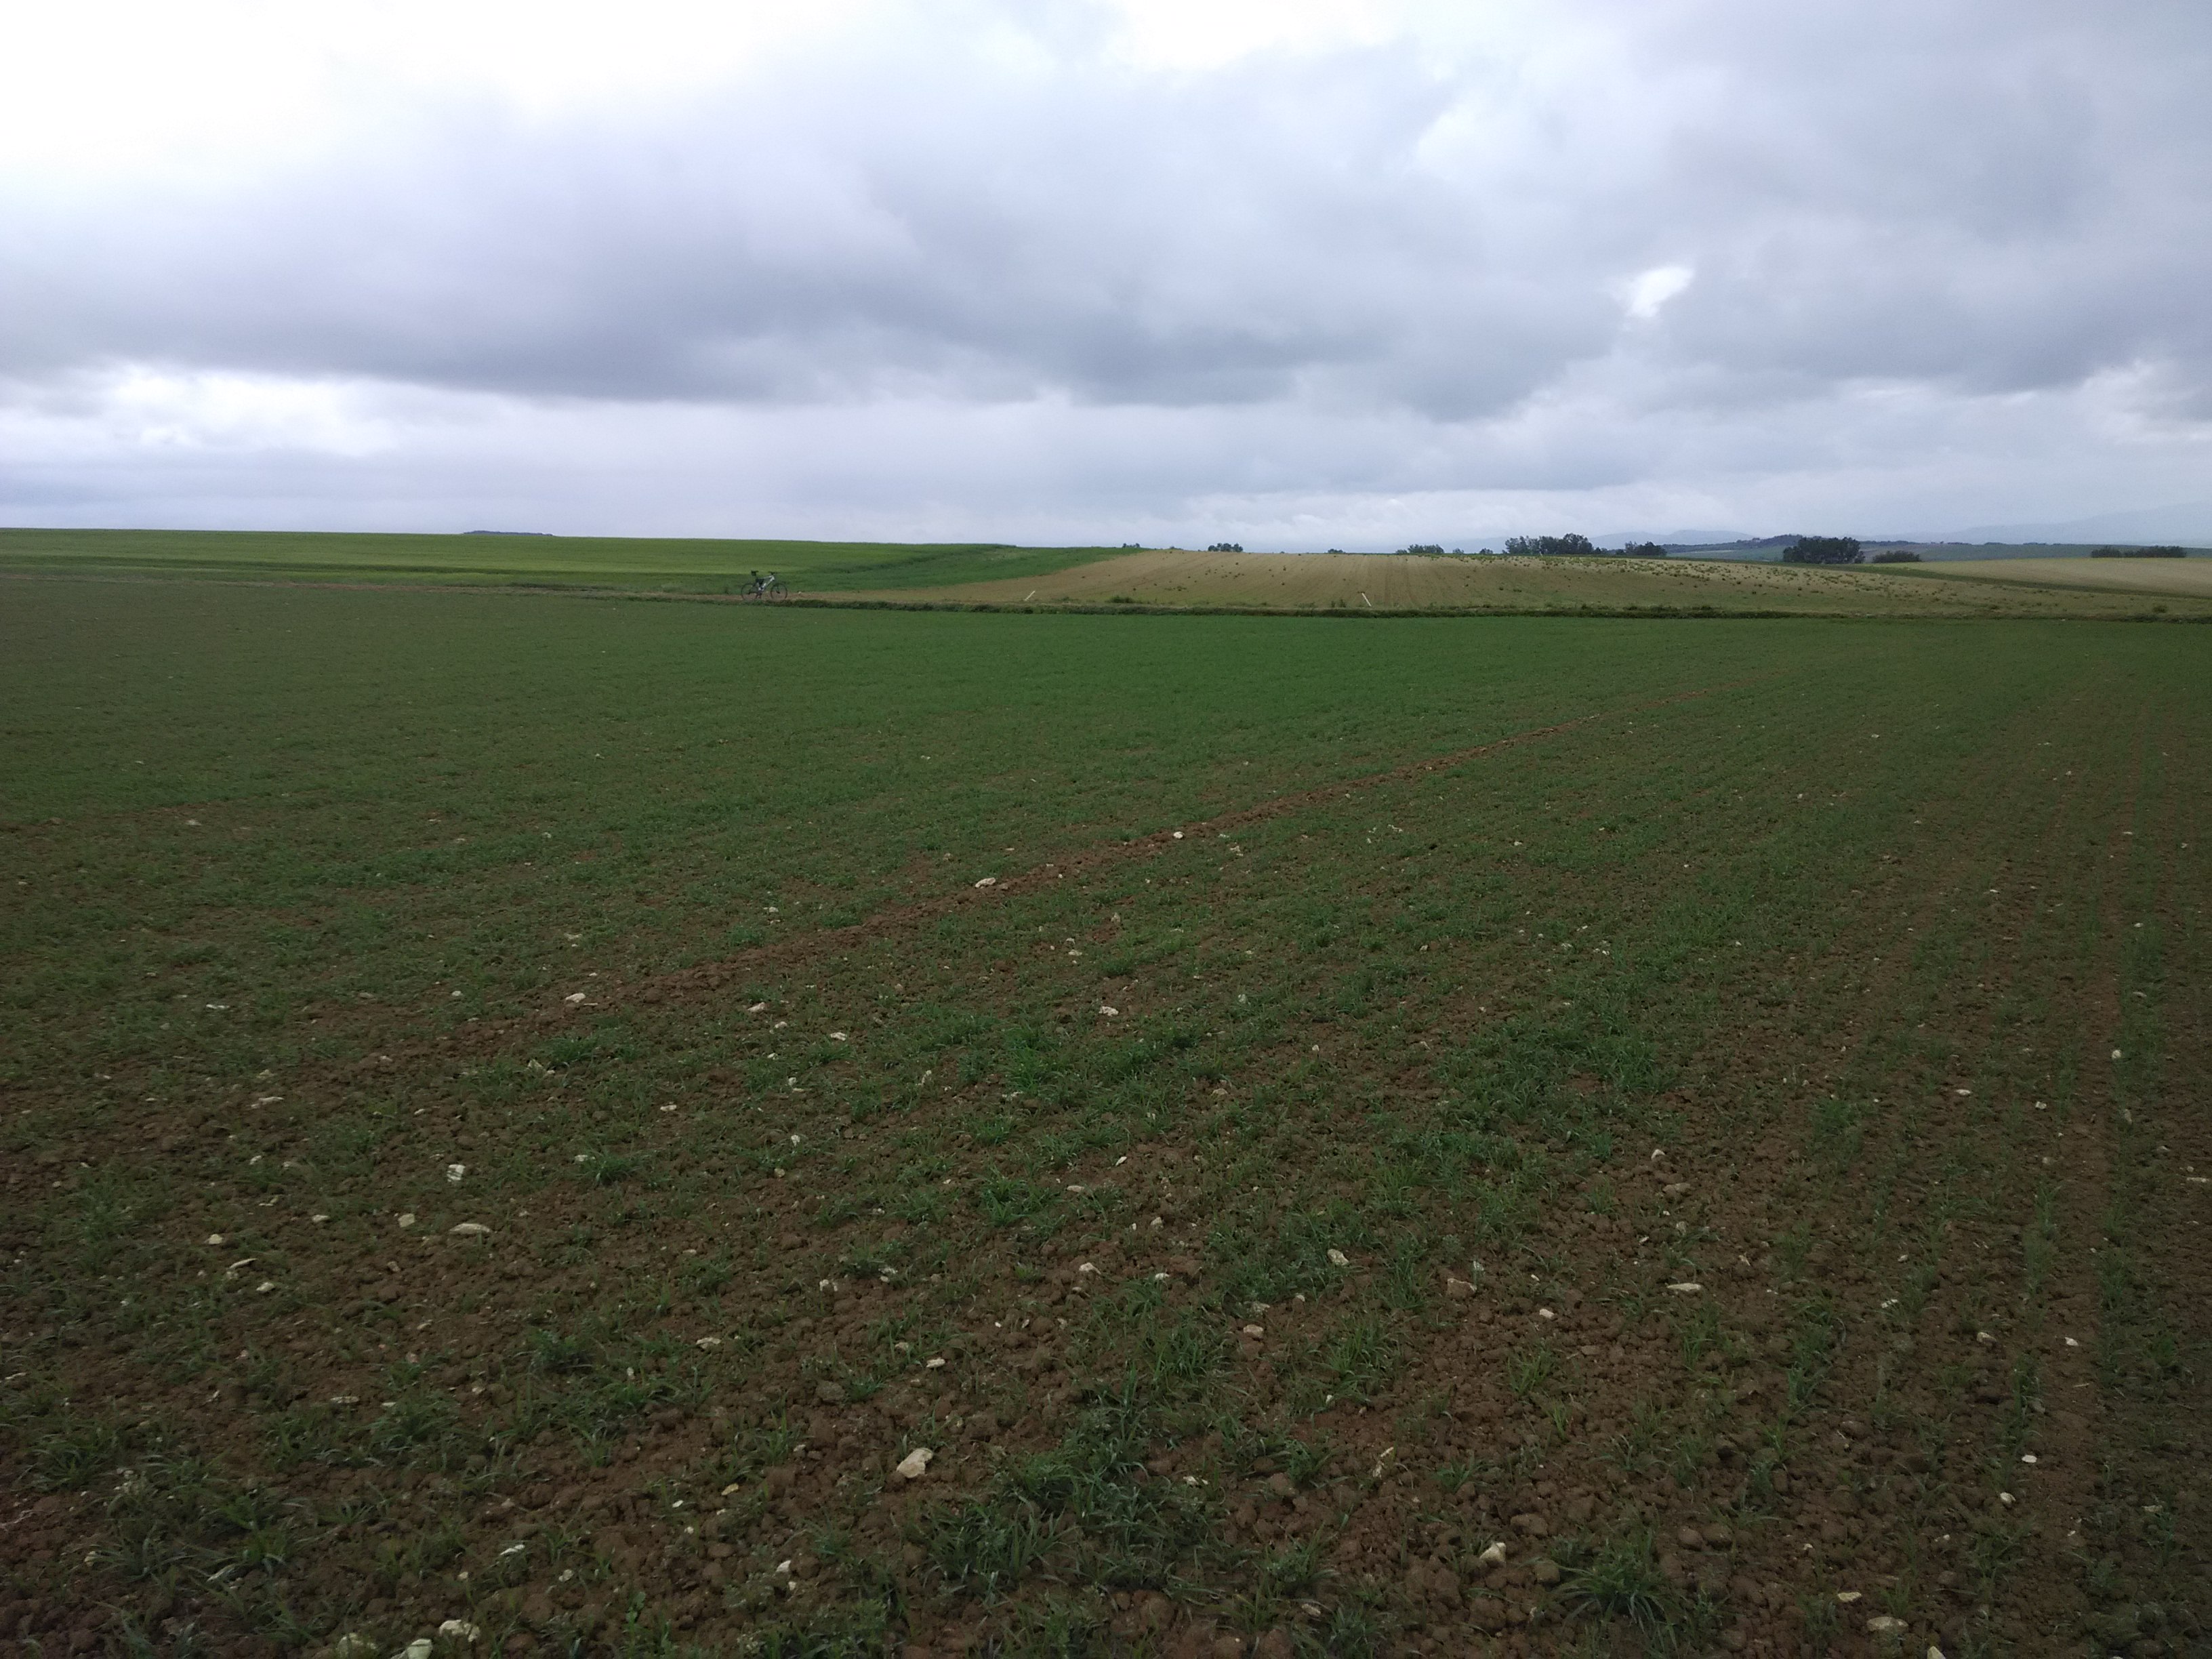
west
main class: Cropland
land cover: Mixed cereals for fodder
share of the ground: 10 - 25 %
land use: Agriculture (excluding fallow land and kitchen gardens)
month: May
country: ES
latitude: 42.8237
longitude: -2.5133
